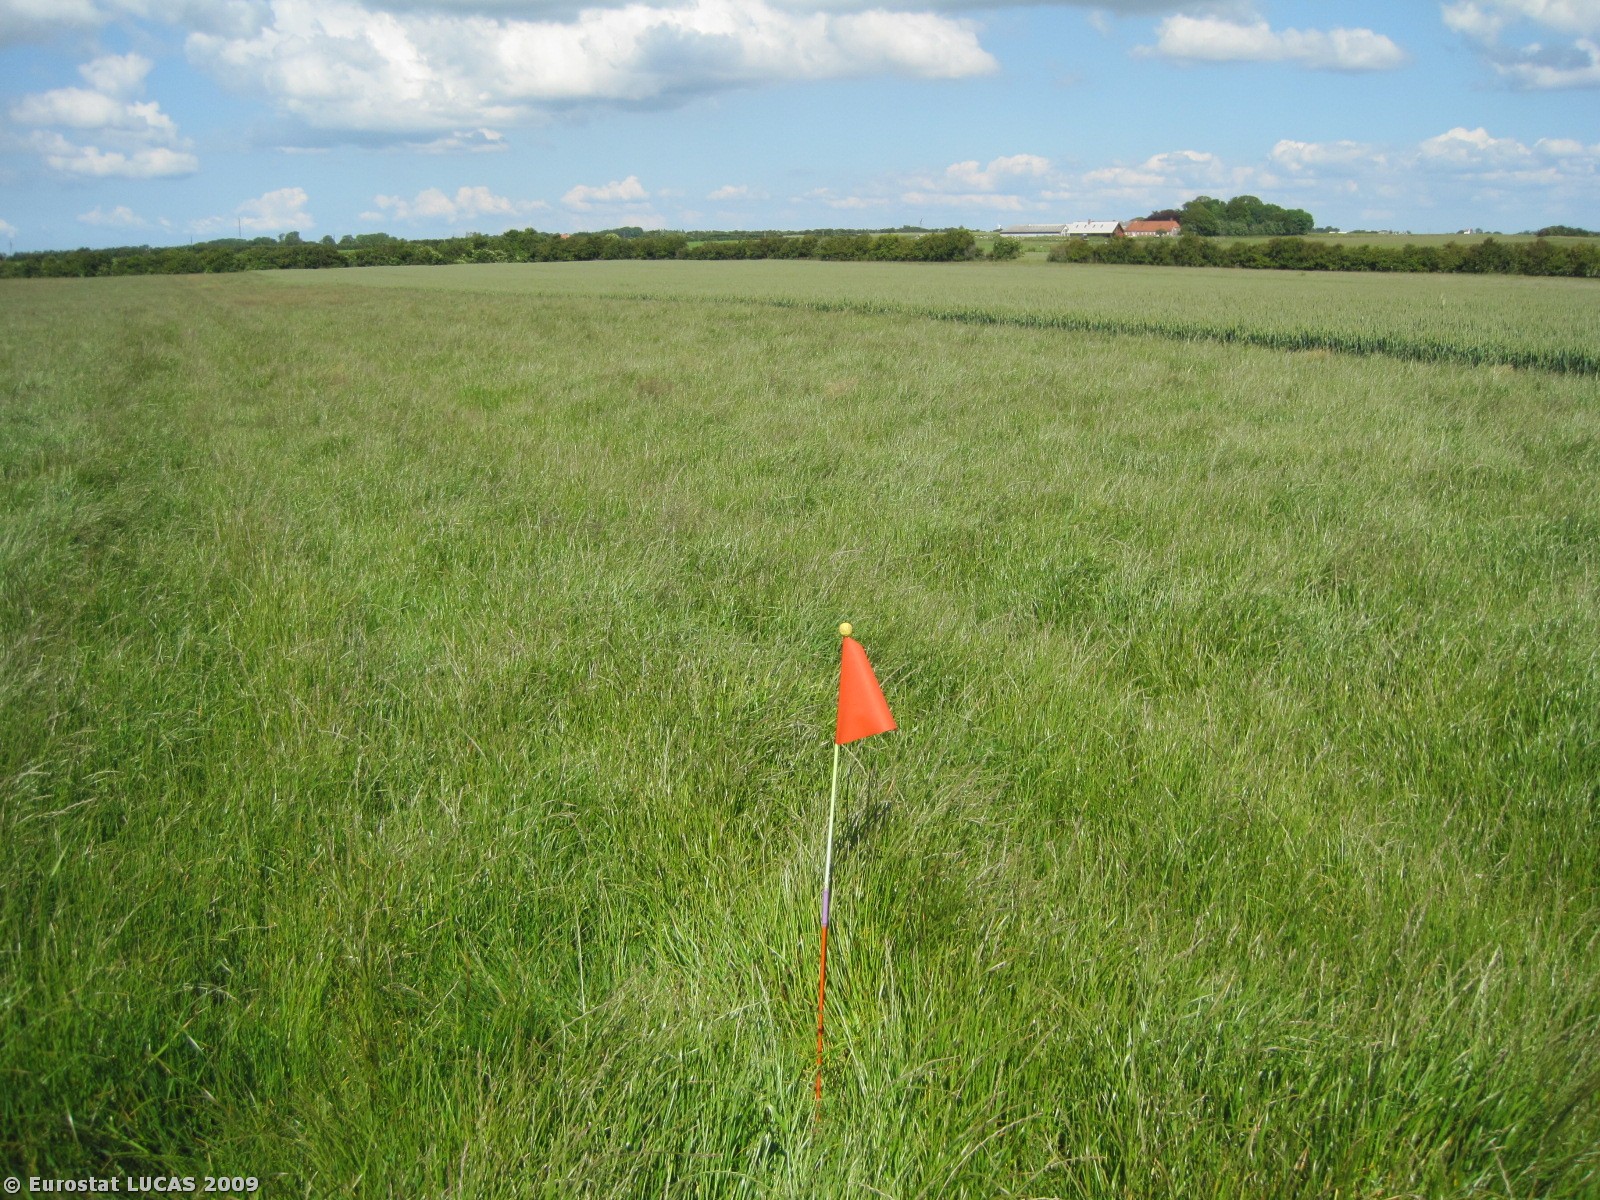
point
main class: Cropland
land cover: Temporary grasslands
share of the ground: > 75 %
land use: Agriculture (excluding fallow land and kitchen gardens)
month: June
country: DK
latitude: 56.6146
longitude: 8.9097
